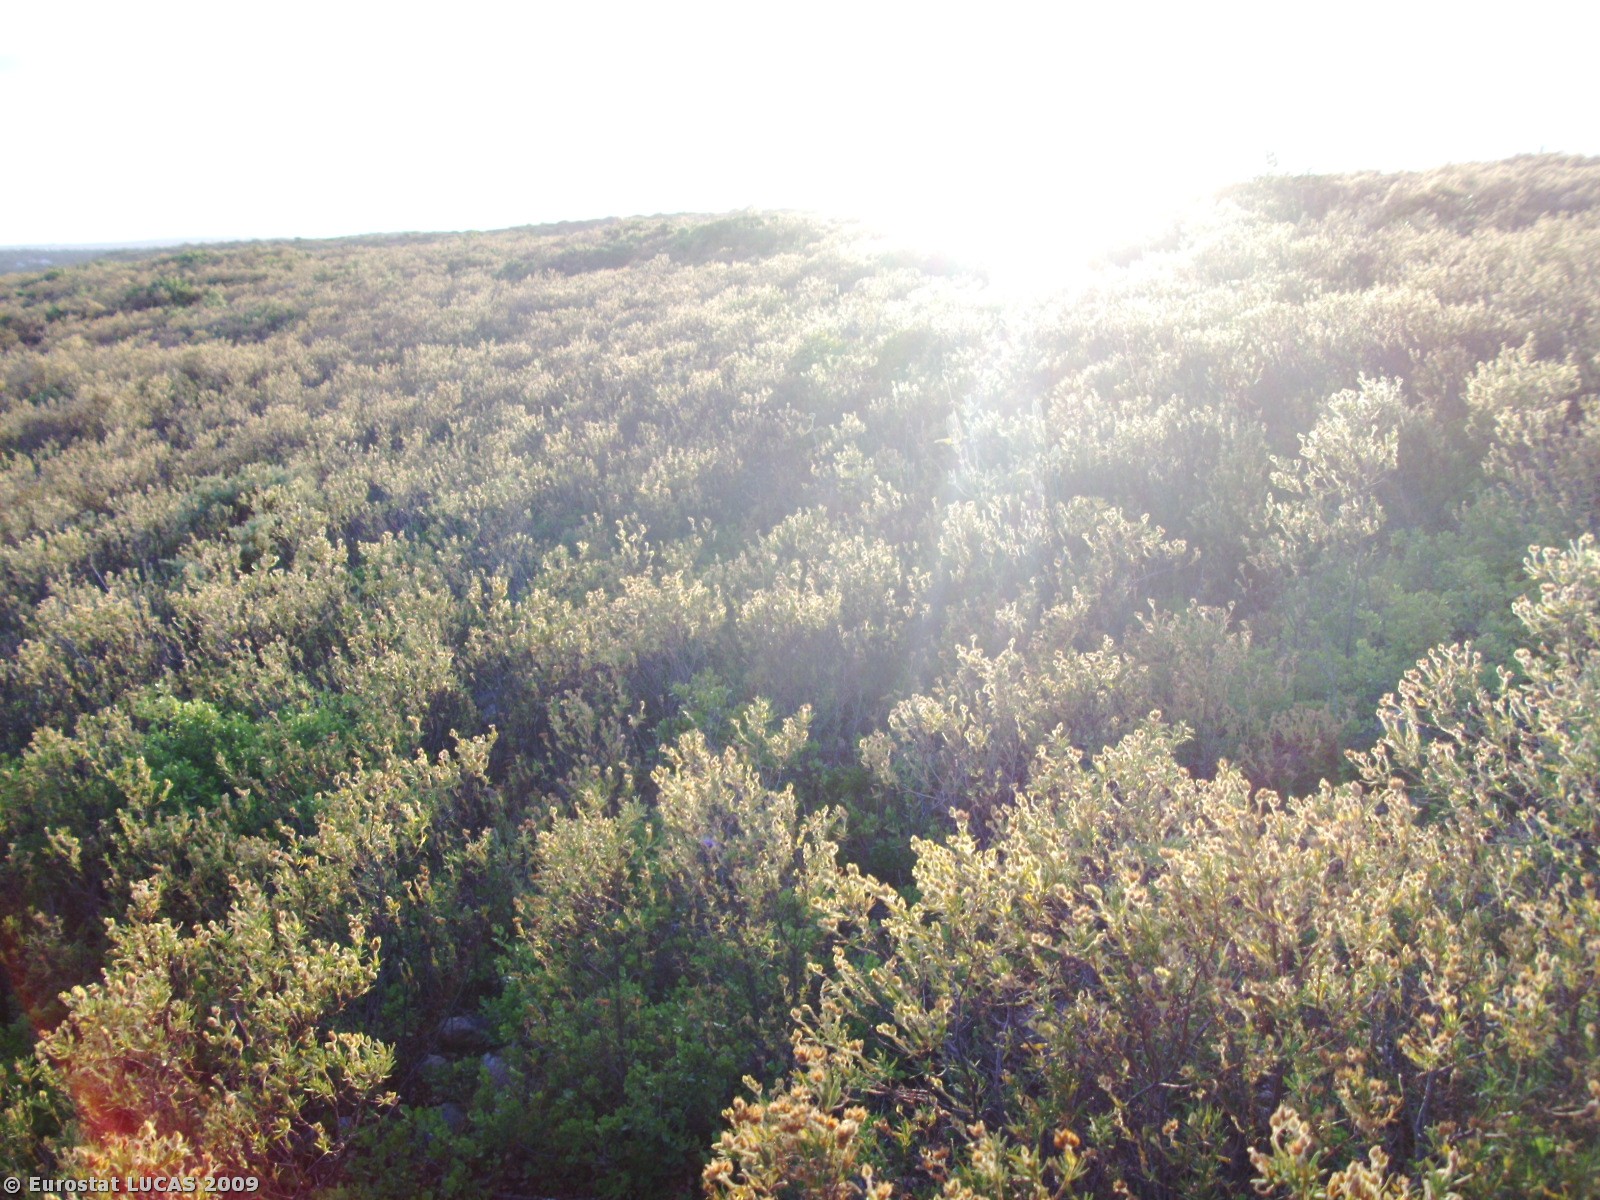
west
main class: Shrubland
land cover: Shrubland without tree cover
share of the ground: > 75 %
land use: Unused
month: June
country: PT
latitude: 37.1523
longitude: -8.7096
